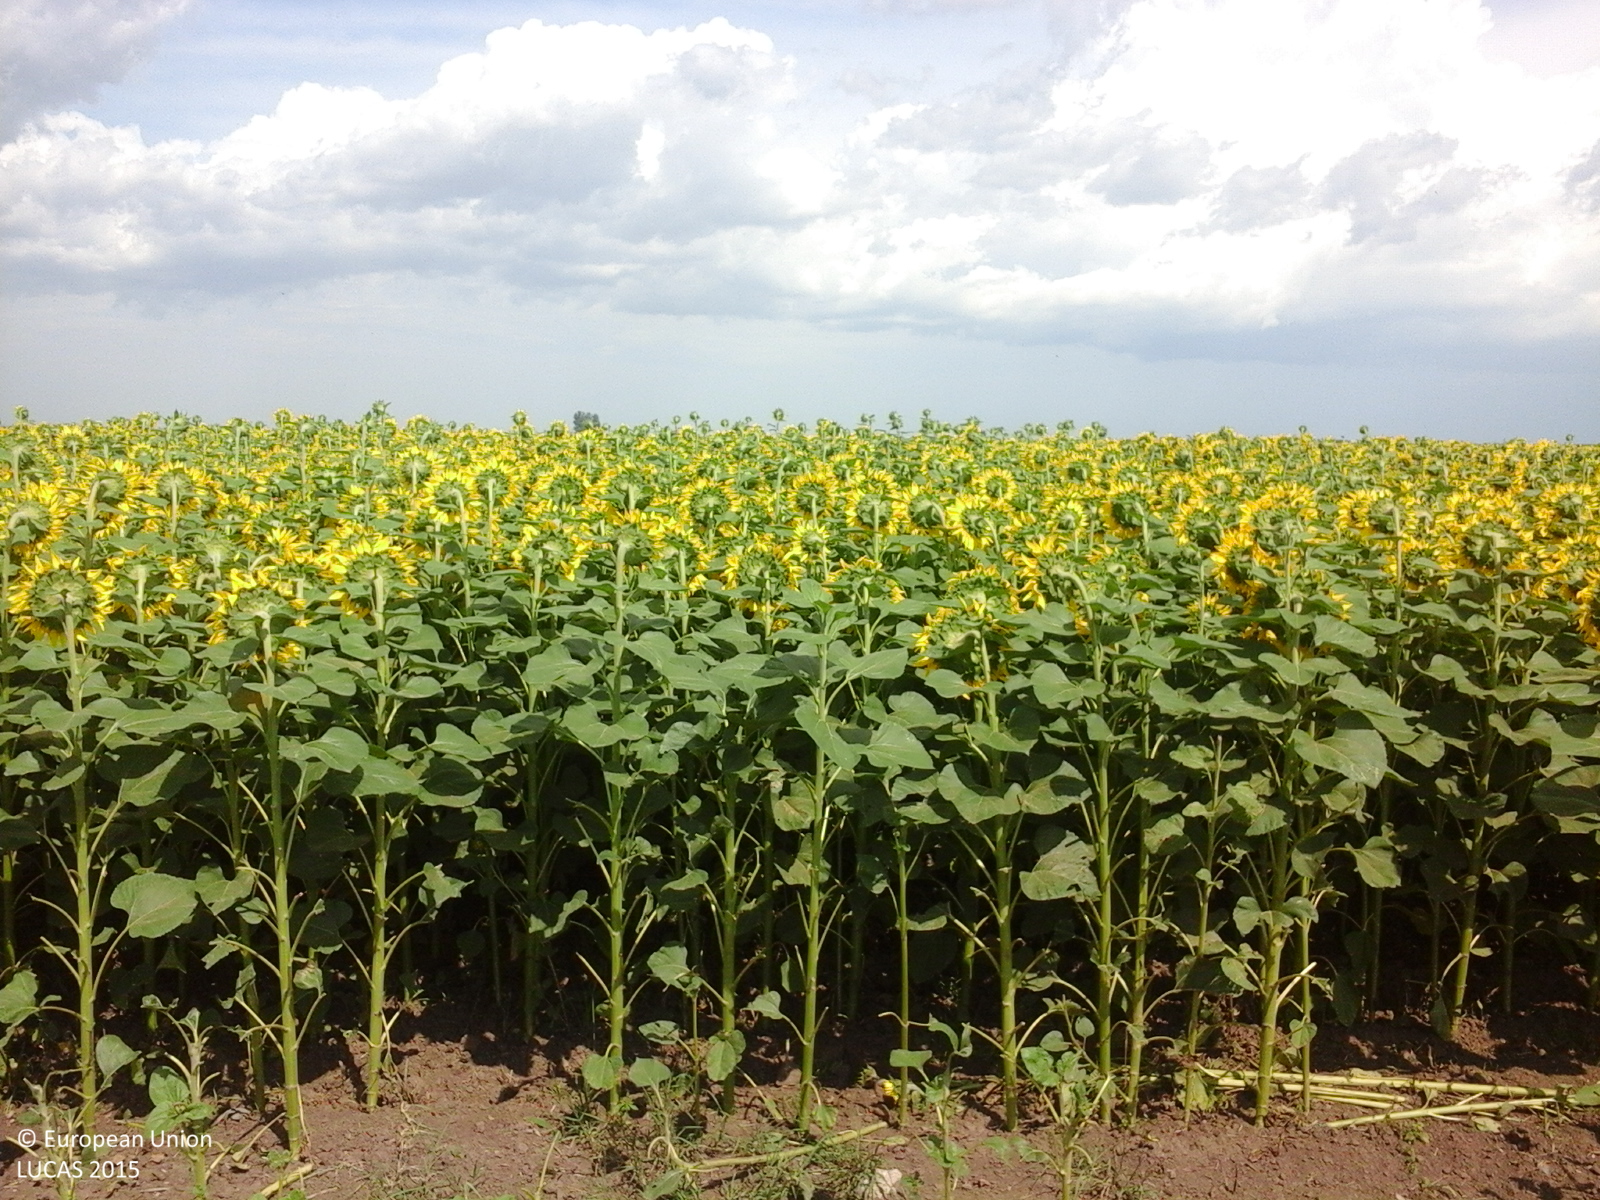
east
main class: Cropland
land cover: Sunflower
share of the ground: > 75 %
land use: Agriculture (excluding fallow land and kitchen gardens)
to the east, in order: Sunflower; Other leguminous and mixtures for fodder; Lucerne; Maize; Other fresh vegetables; Common wheat; Spontaneously vegetated surfaces; Lucerne; Maize
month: July
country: RO
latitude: 43.8230
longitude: 24.3486
